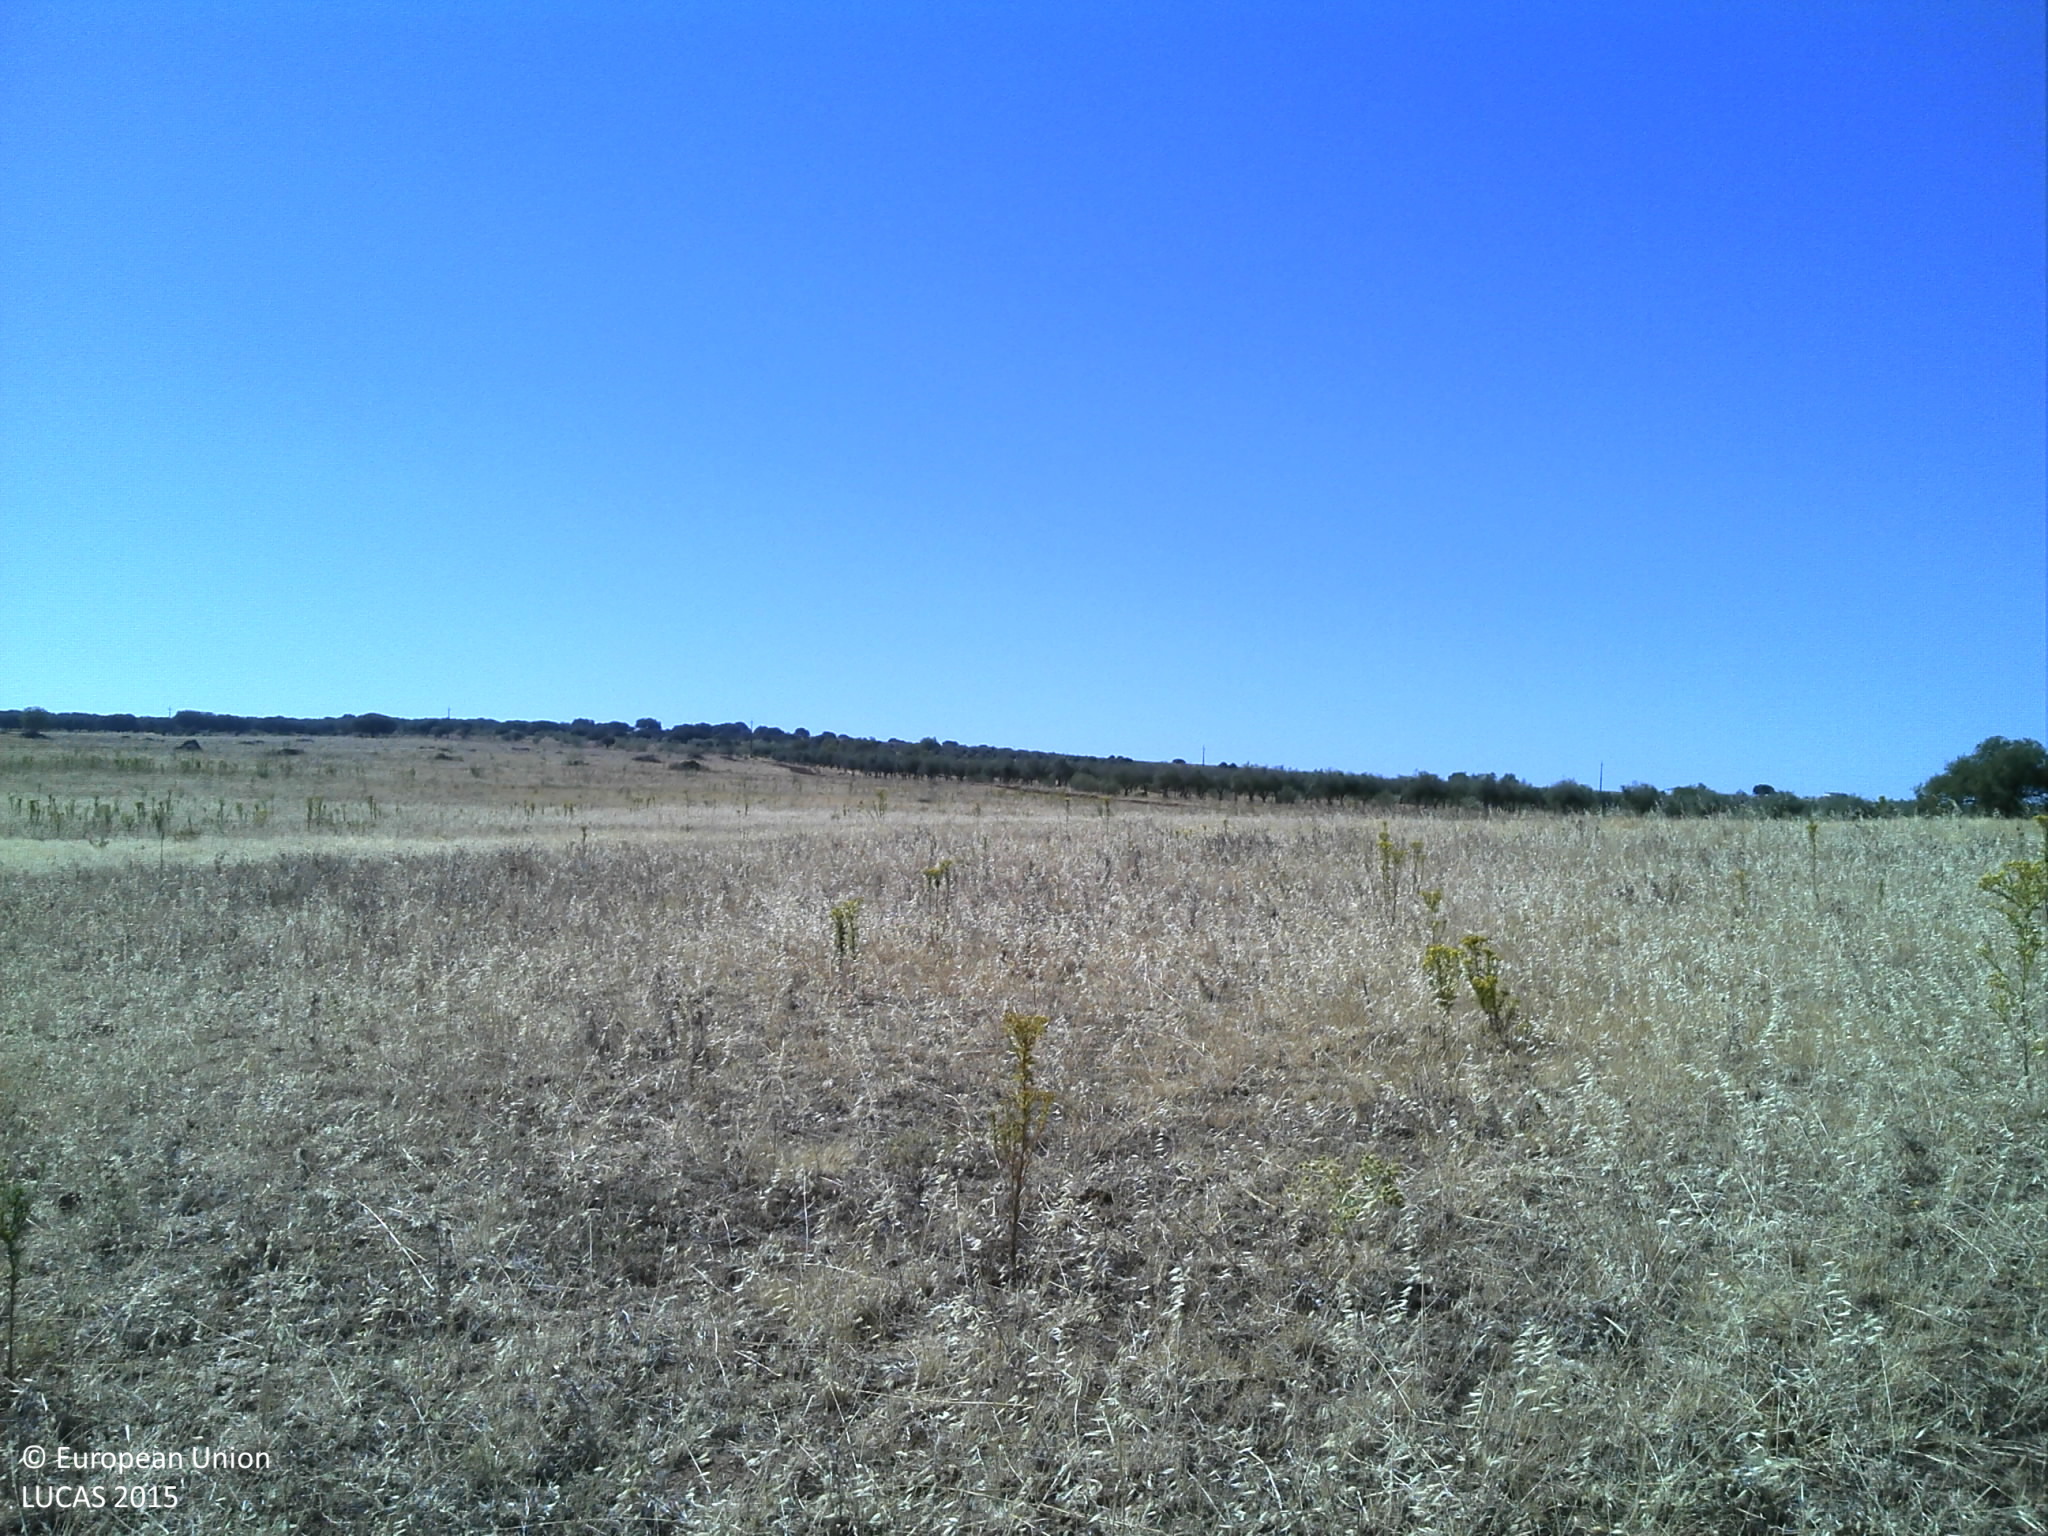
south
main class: Grassland
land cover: Grassland without tree/shrub cover
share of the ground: 10 - 25 %
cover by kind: unconsolidated bare surface 85 %, herbaceous plants 15 %
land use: Agriculture (excluding fallow land and kitchen gardens)
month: July
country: PT
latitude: 38.9600
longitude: -7.2847
